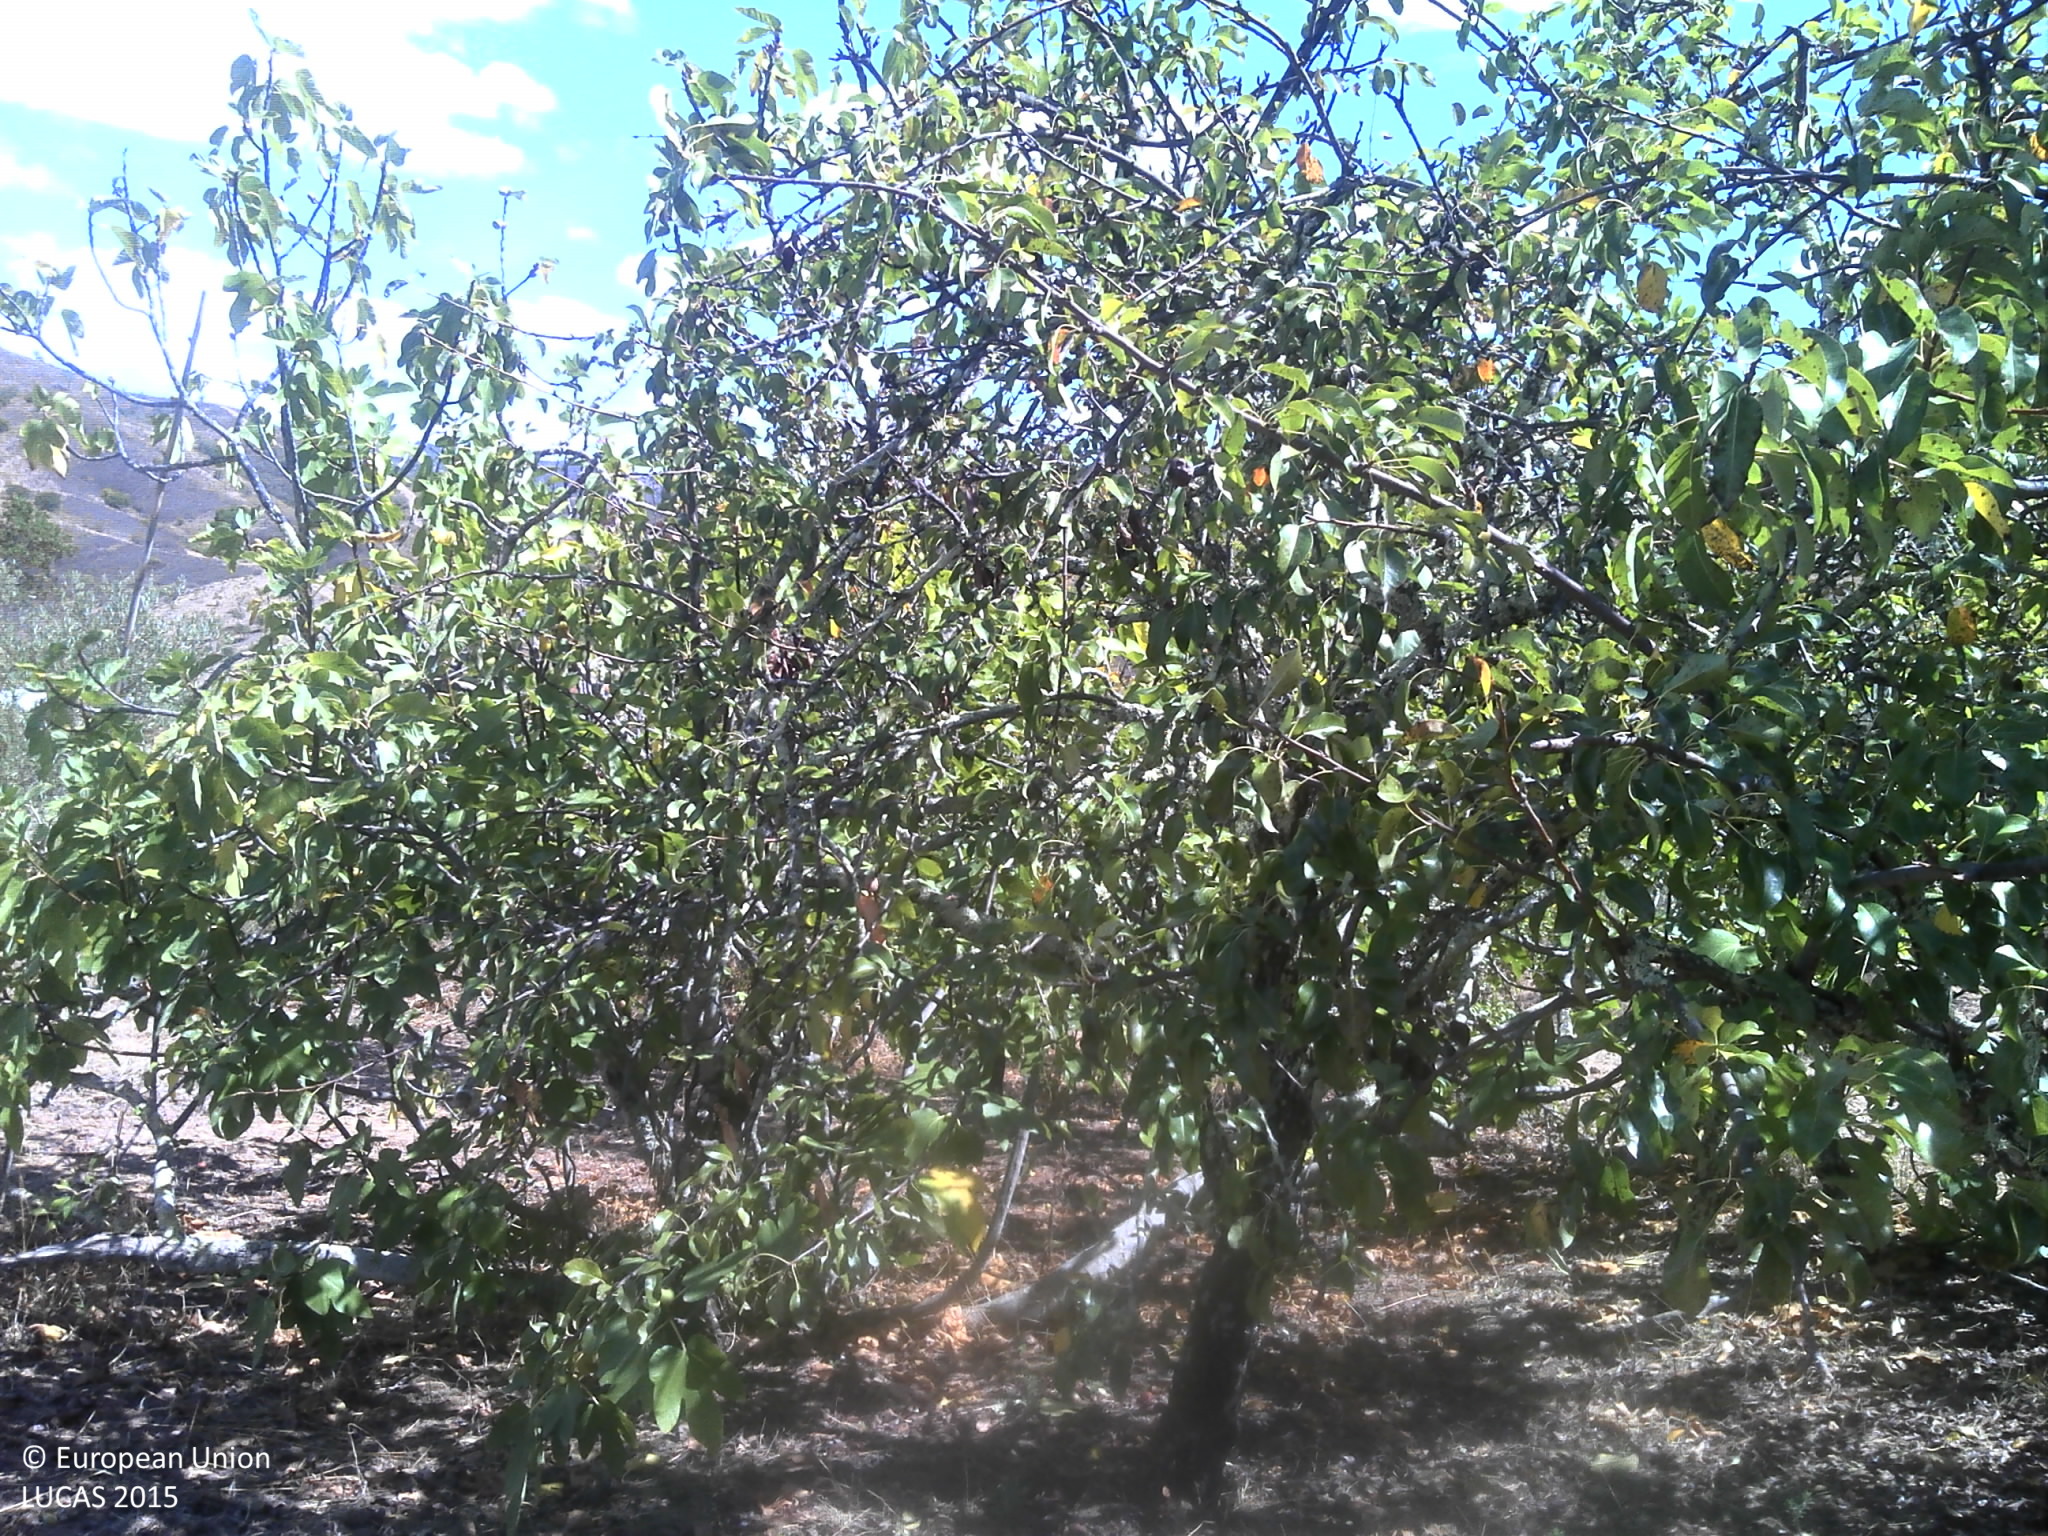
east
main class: Cropland
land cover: Pear fruit
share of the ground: 25 - 50 %
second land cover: Grassland without tree/shrub cover
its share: 25 - 50 %
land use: Agriculture (excluding fallow land and kitchen gardens)
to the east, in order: Pear fruit; Grassland without tree/shrub cover; Other fruit trees and berries; Olive groves; Broadleaved woodland; Rivers and streams; Shrubland without tree cover; Inland fresh running water; Shrubland with sparse tree cover; Grassland without tree/shrub cover; Artificial constructions in urban areas
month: September
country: PT
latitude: 37.3136
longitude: -8.1758
